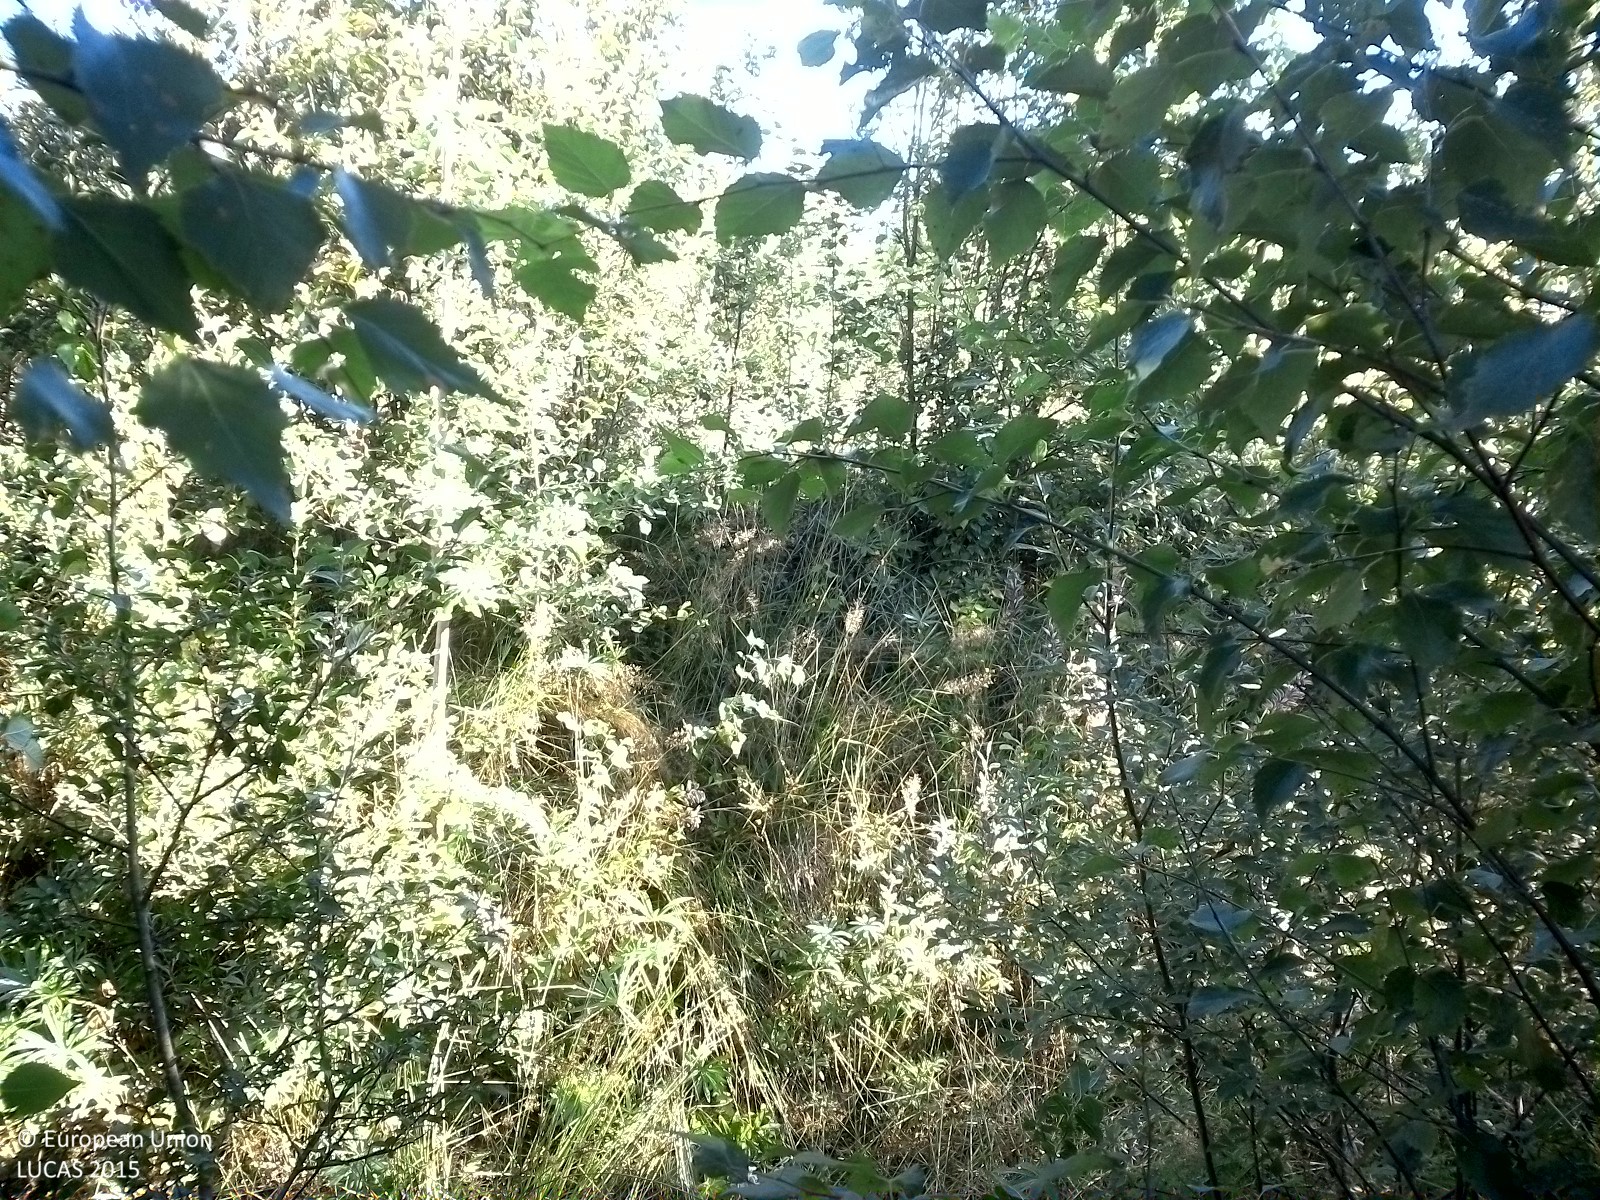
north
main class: Woodland
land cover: Broadleaved woodland
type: hemiboreal forest and nemoral coniferous forest and mixed broadleaved-coniferous forest
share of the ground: 50 - 75 %
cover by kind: broadleaved forest trees 70 %, herbaceous plants 30 %
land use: Semi-natural and natural areas not in use
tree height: < 5 m
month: August
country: SE
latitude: 59.2397
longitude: 15.1278
